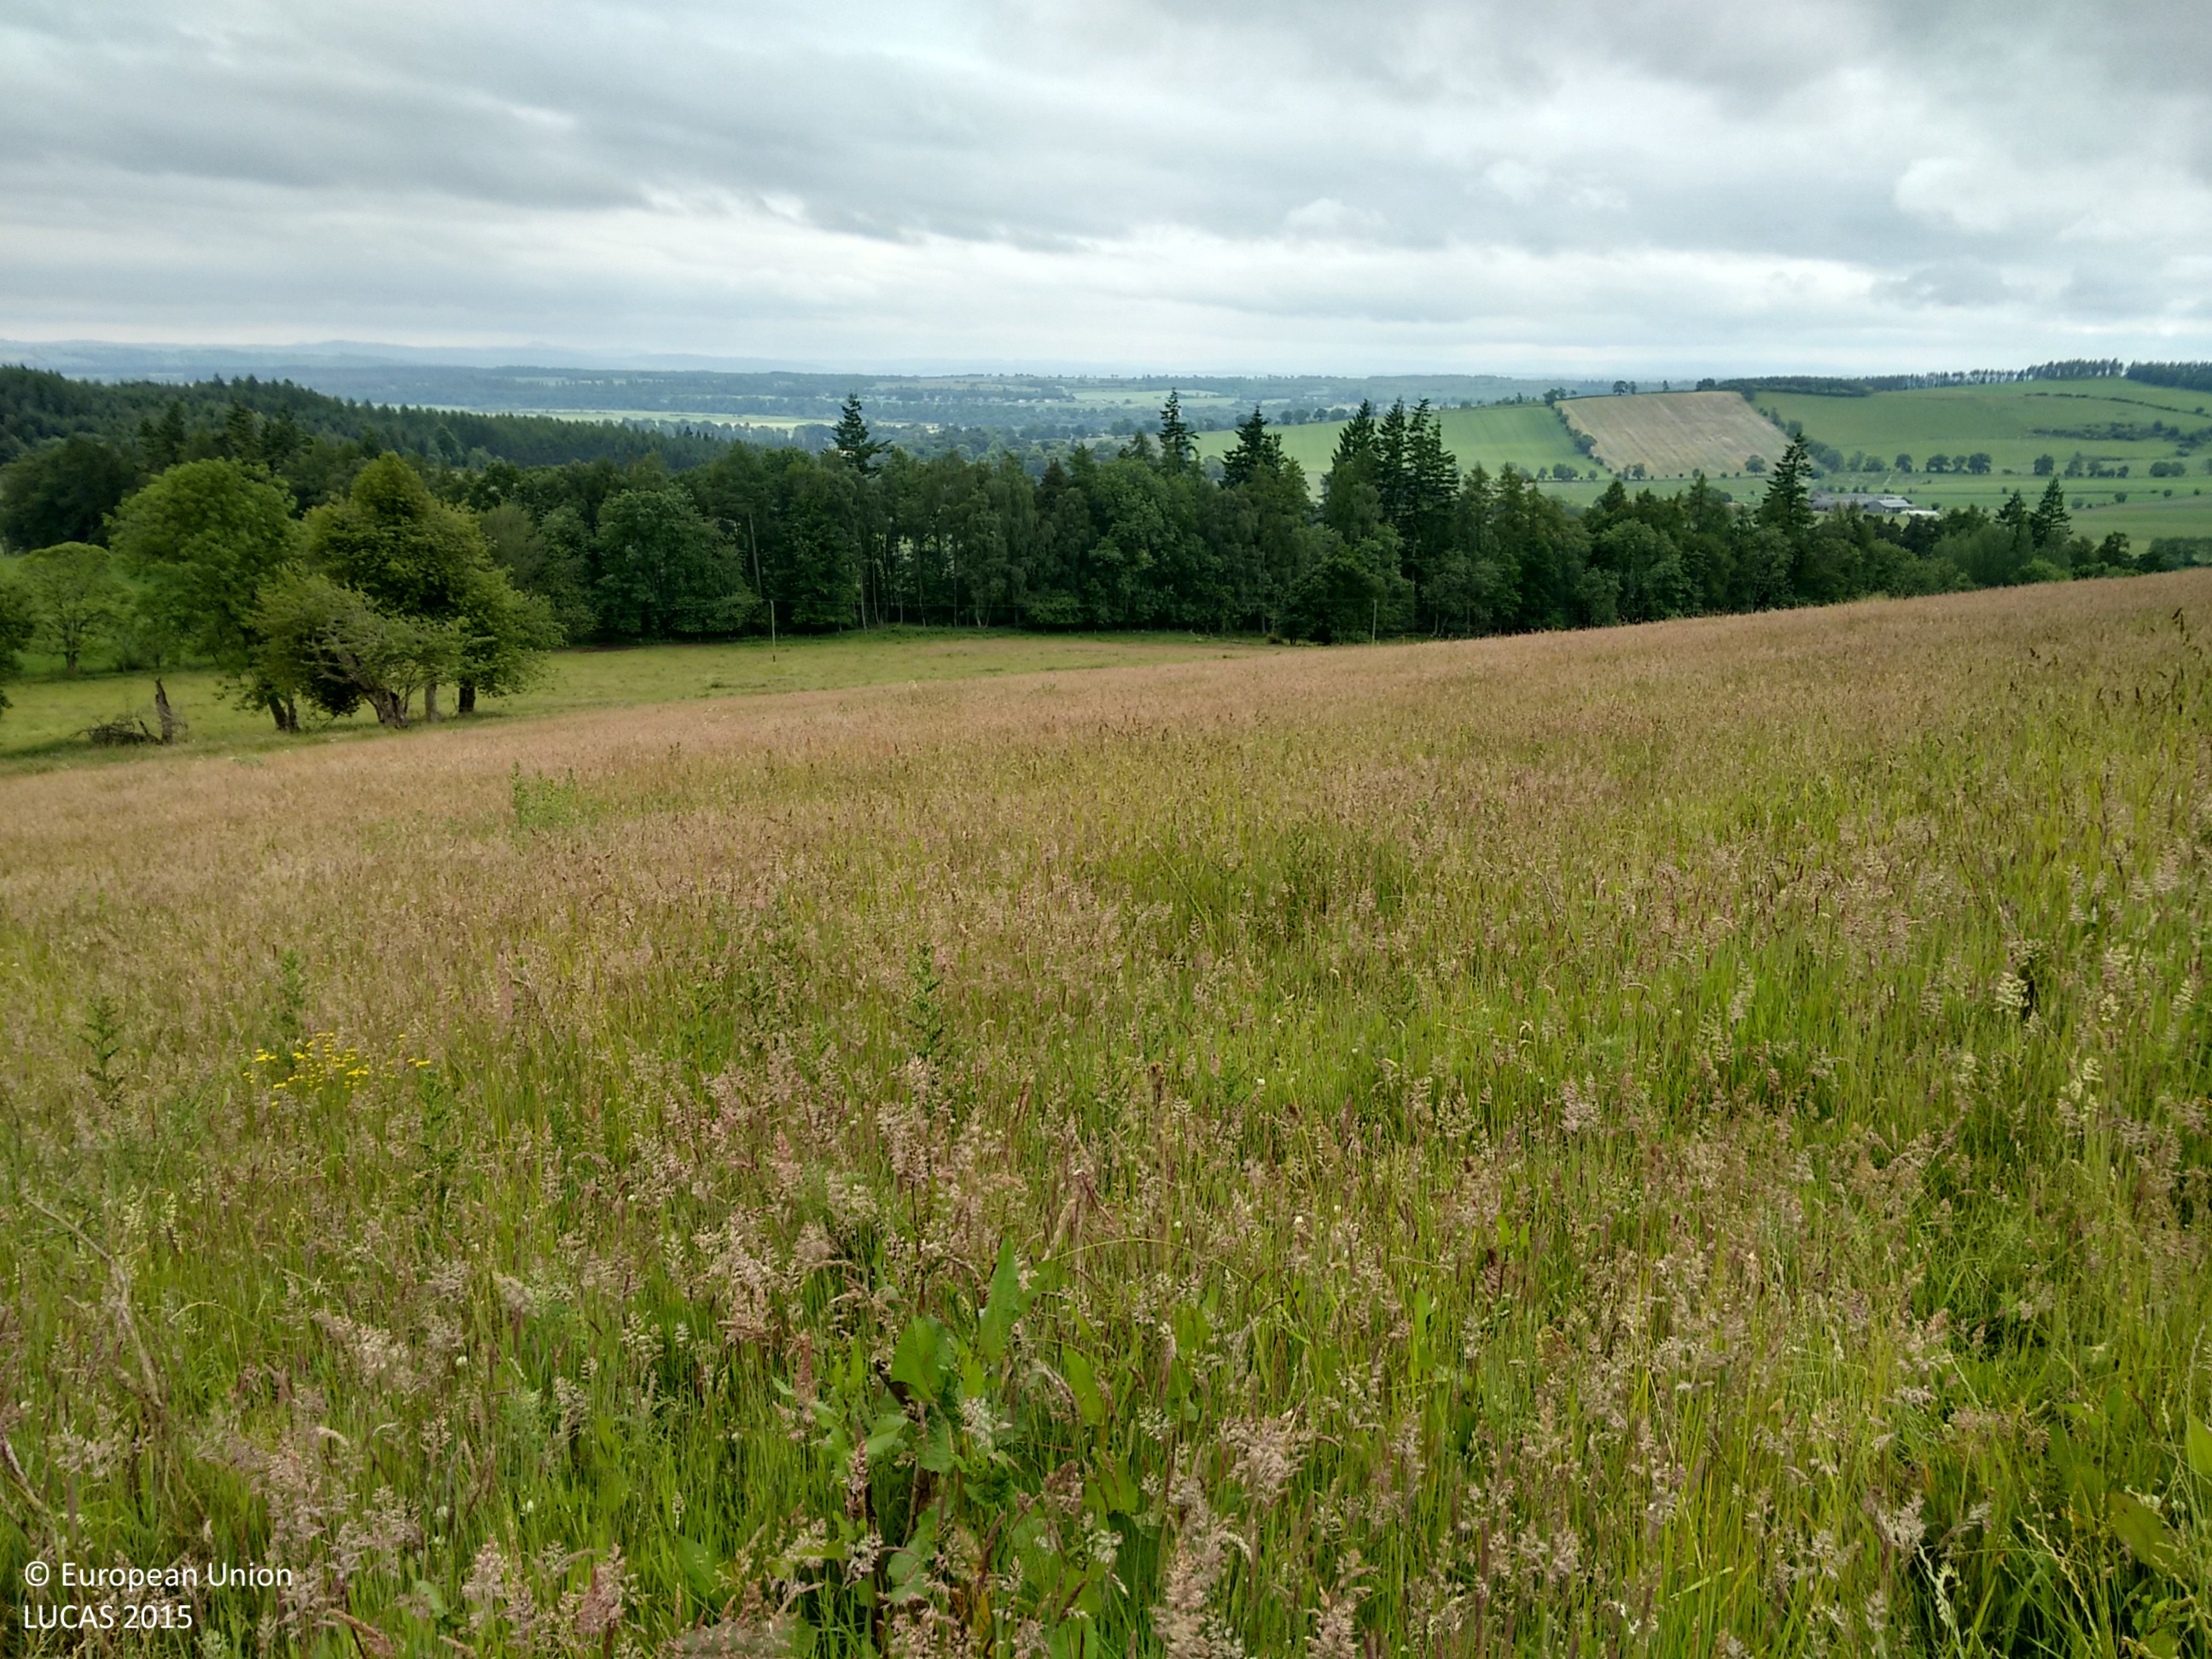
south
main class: Grassland
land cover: Spontaneously vegetated surfaces
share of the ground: > 75 %
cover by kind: herbaceous plants 100 %
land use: Semi-natural and natural areas not in use
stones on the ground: 10 - 25 %
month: June
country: GB
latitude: 56.5690
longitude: -3.4684
